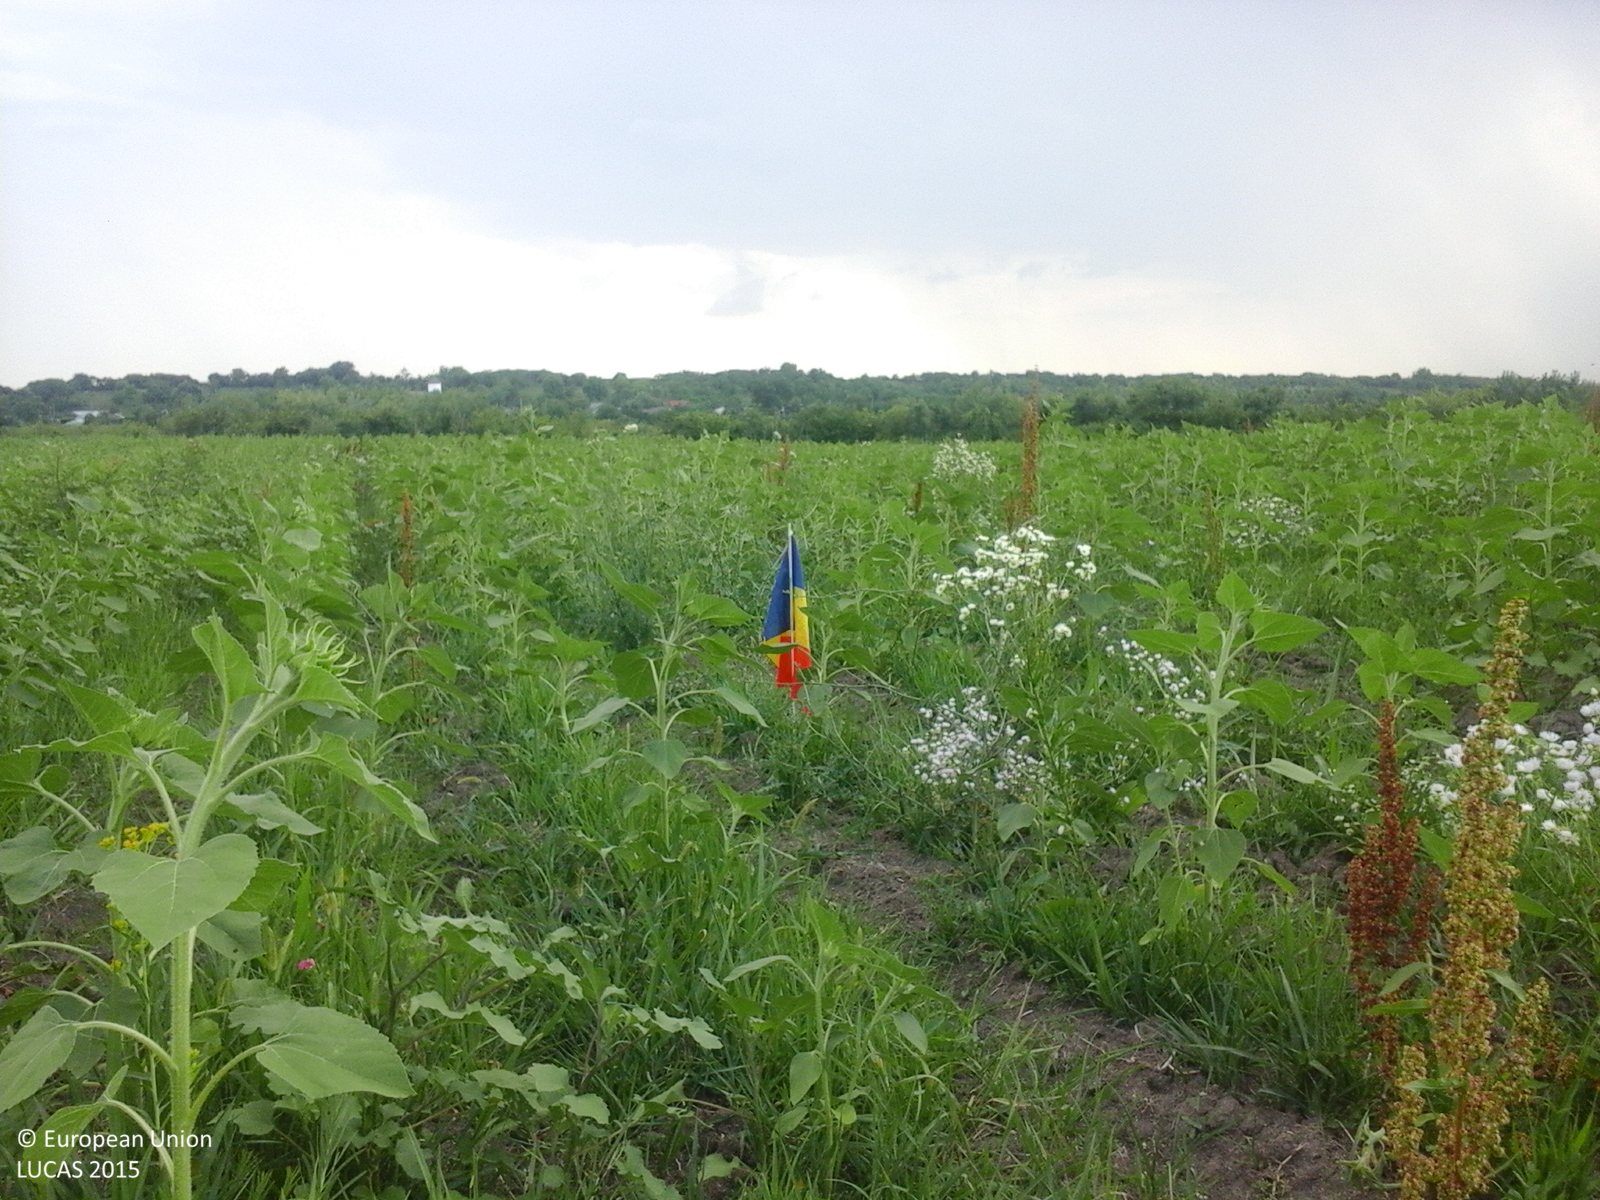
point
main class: Cropland
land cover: Sunflower
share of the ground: 50 - 75 %
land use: Agriculture (excluding fallow land and kitchen gardens)
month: June
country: RO
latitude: 44.2834
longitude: 25.8230
